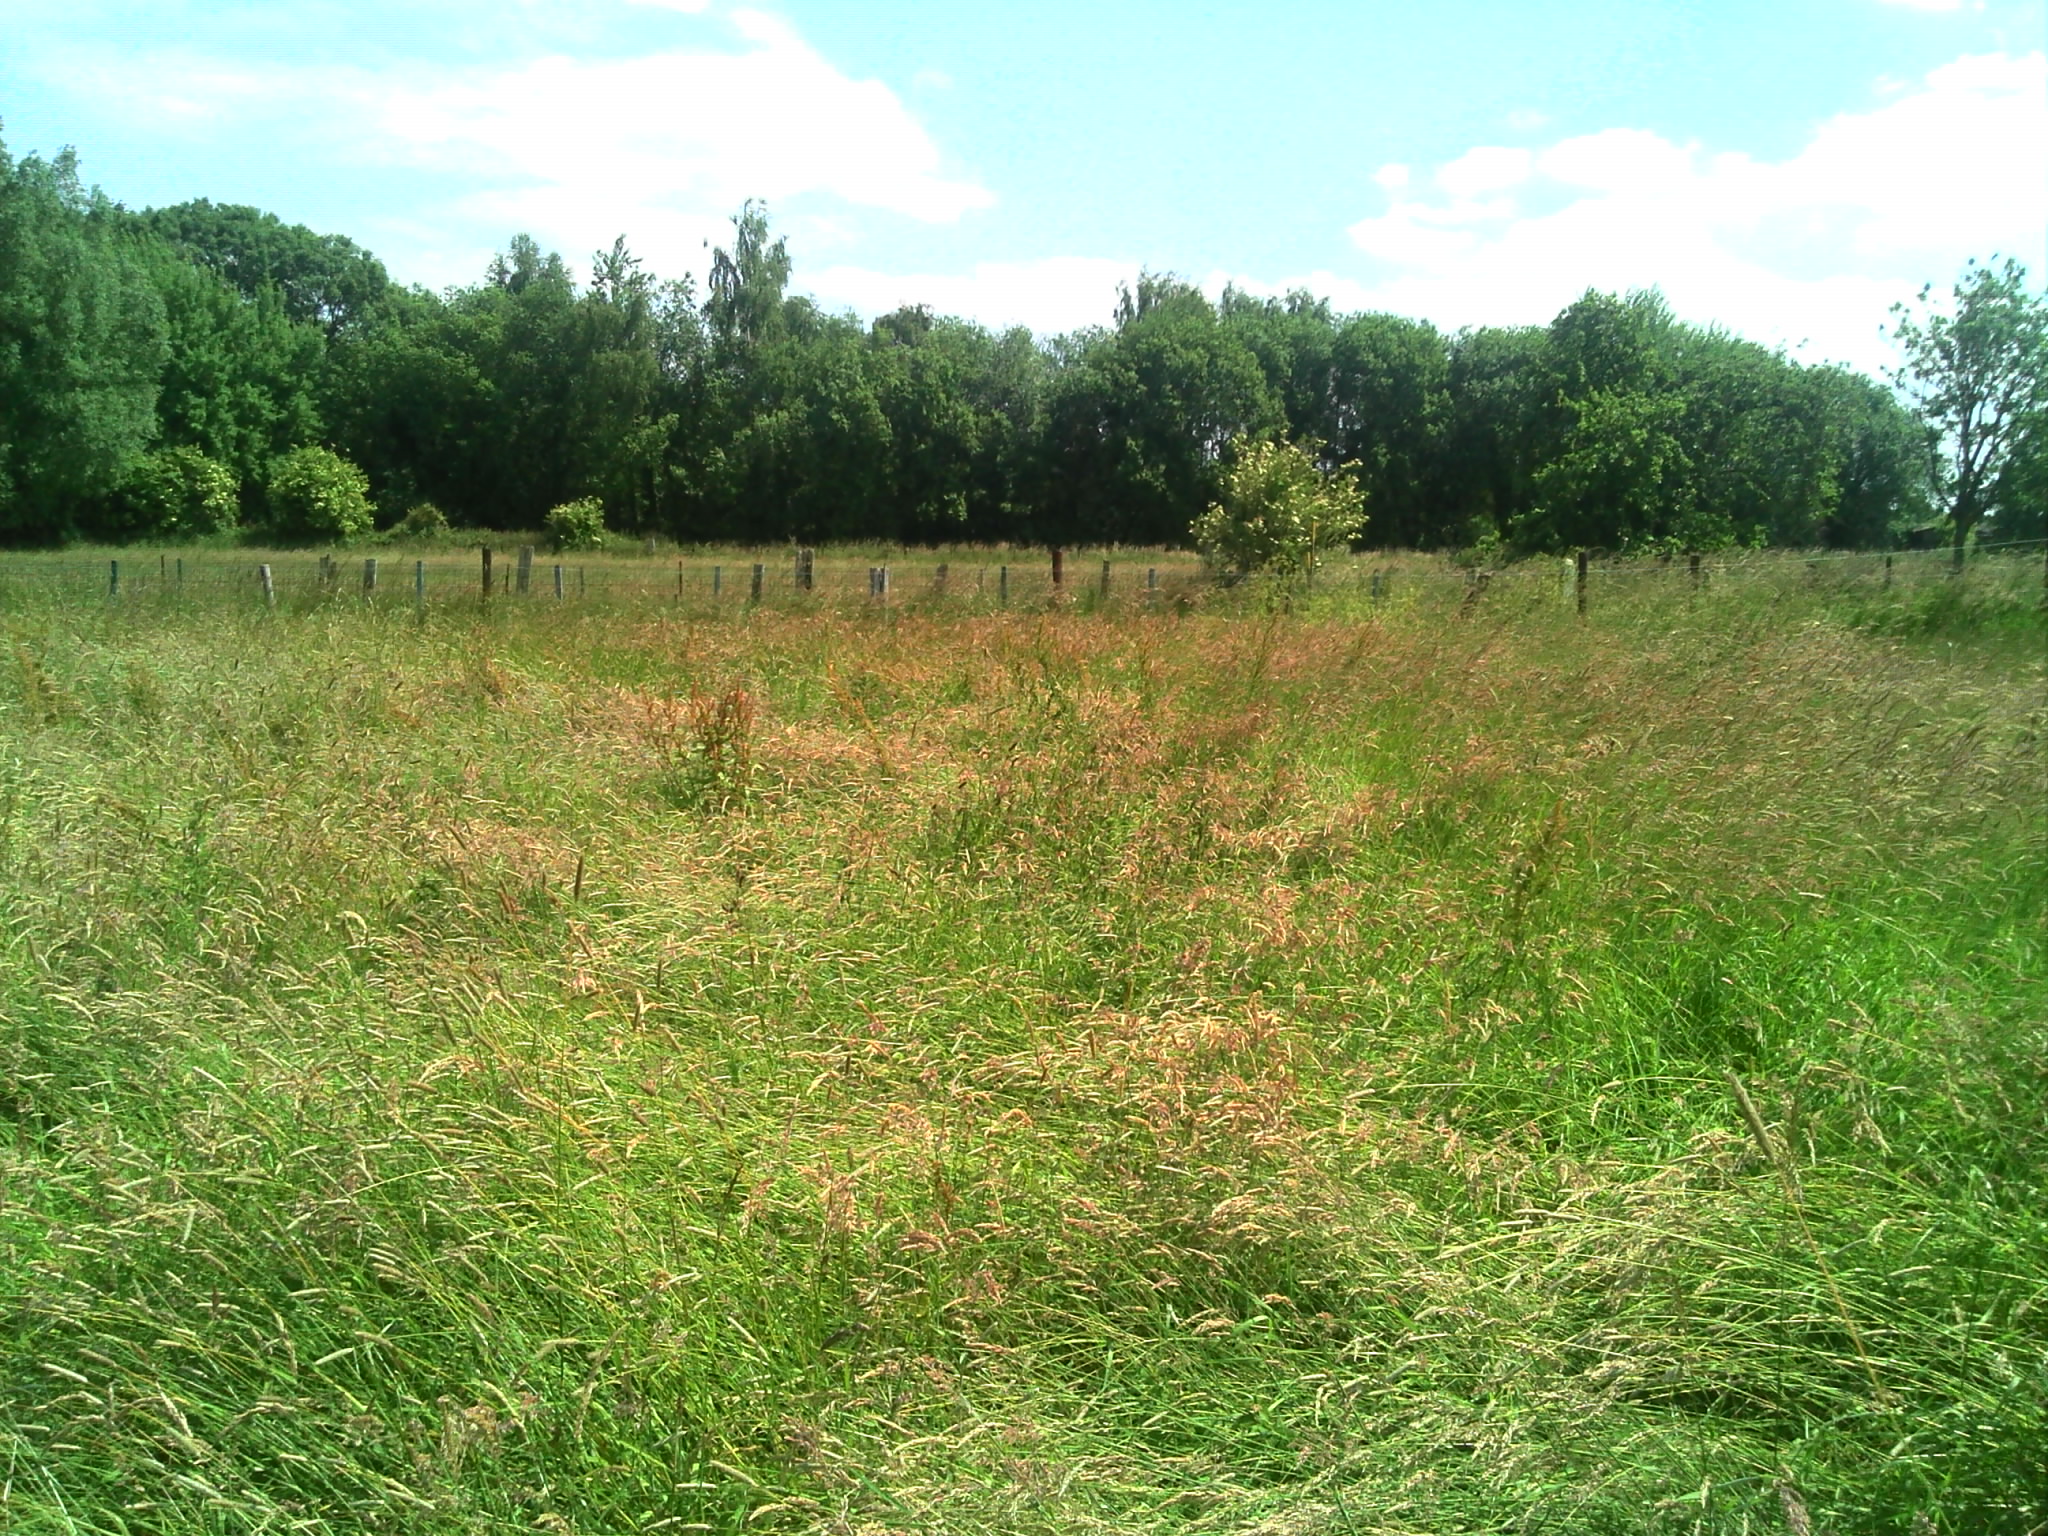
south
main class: Grassland
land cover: Grassland without tree/shrub cover
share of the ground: > 75 %
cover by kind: herbaceous plants 100 %
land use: Agriculture (excluding fallow land and kitchen gardens)
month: June
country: BE
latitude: 50.9079
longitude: 4.3208
